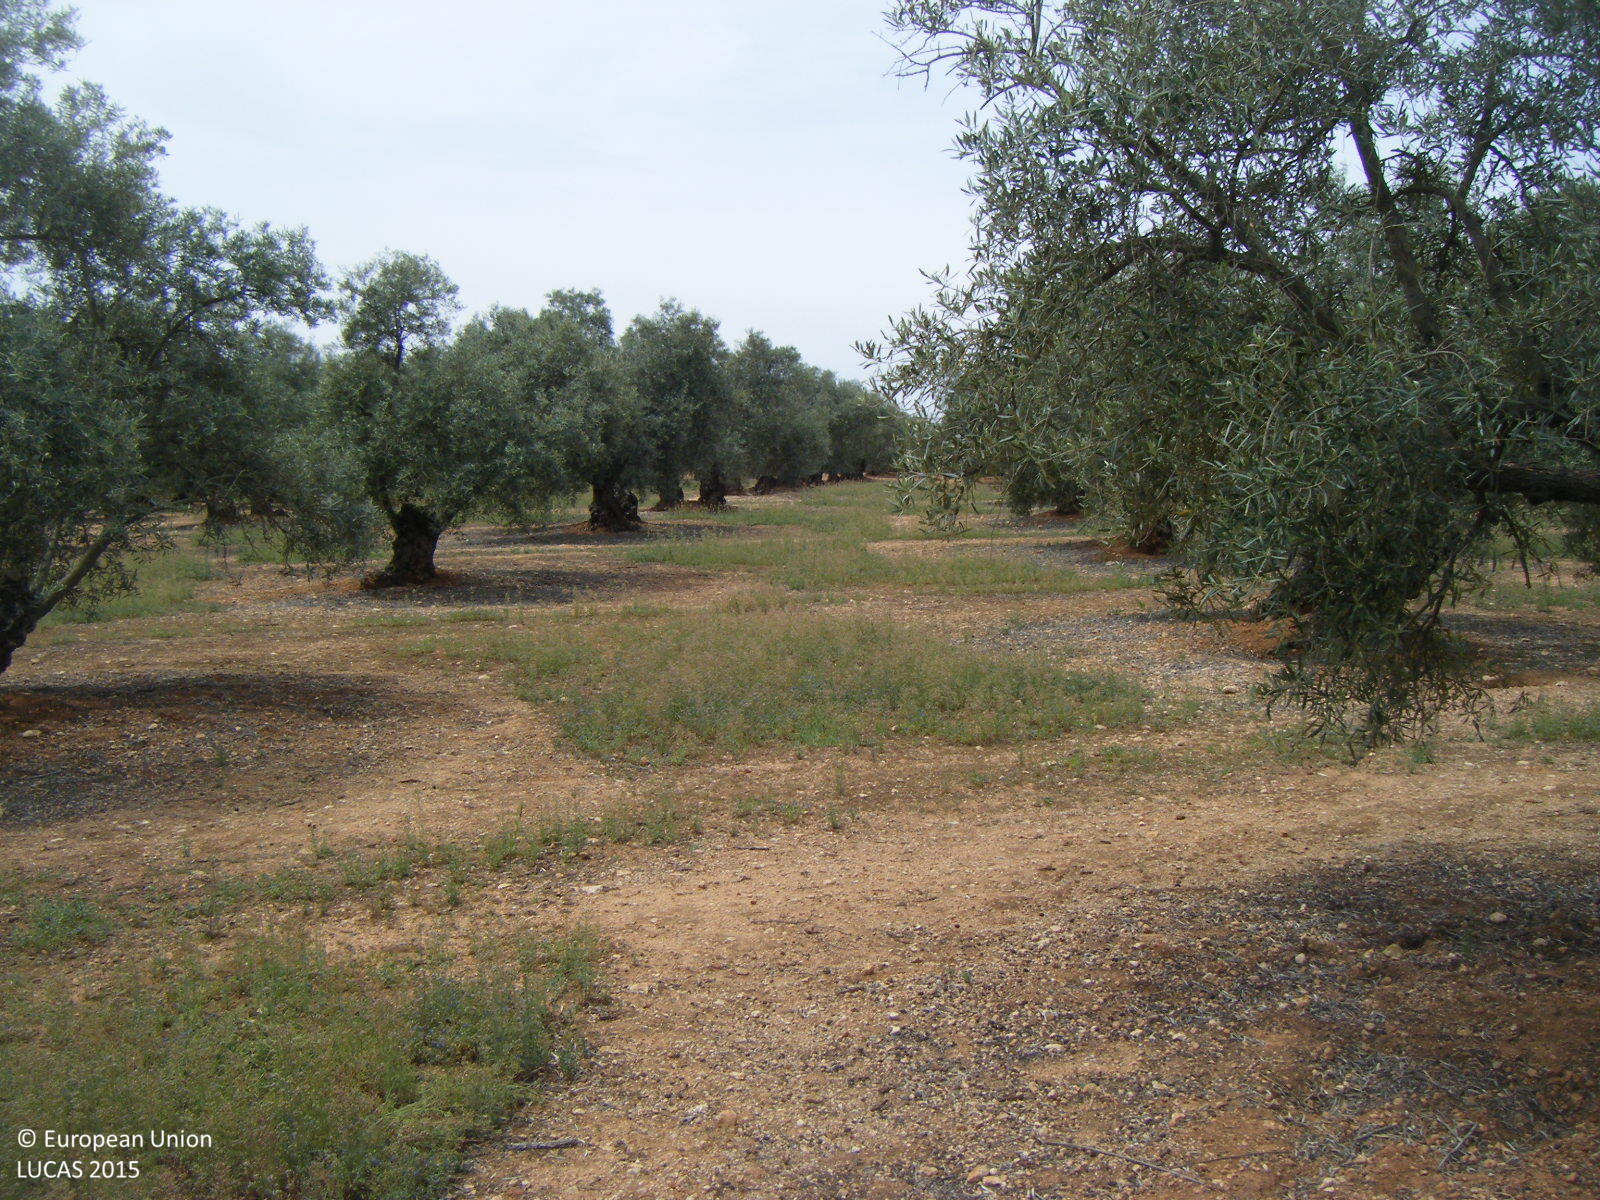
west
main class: Cropland
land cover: Olive groves
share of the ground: 25 - 50 %
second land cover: Spontaneously vegetated surfaces
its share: 50 - 75 %
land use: Agriculture (excluding fallow land and kitchen gardens)
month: April
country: ES
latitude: 37.1586
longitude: -4.7641
